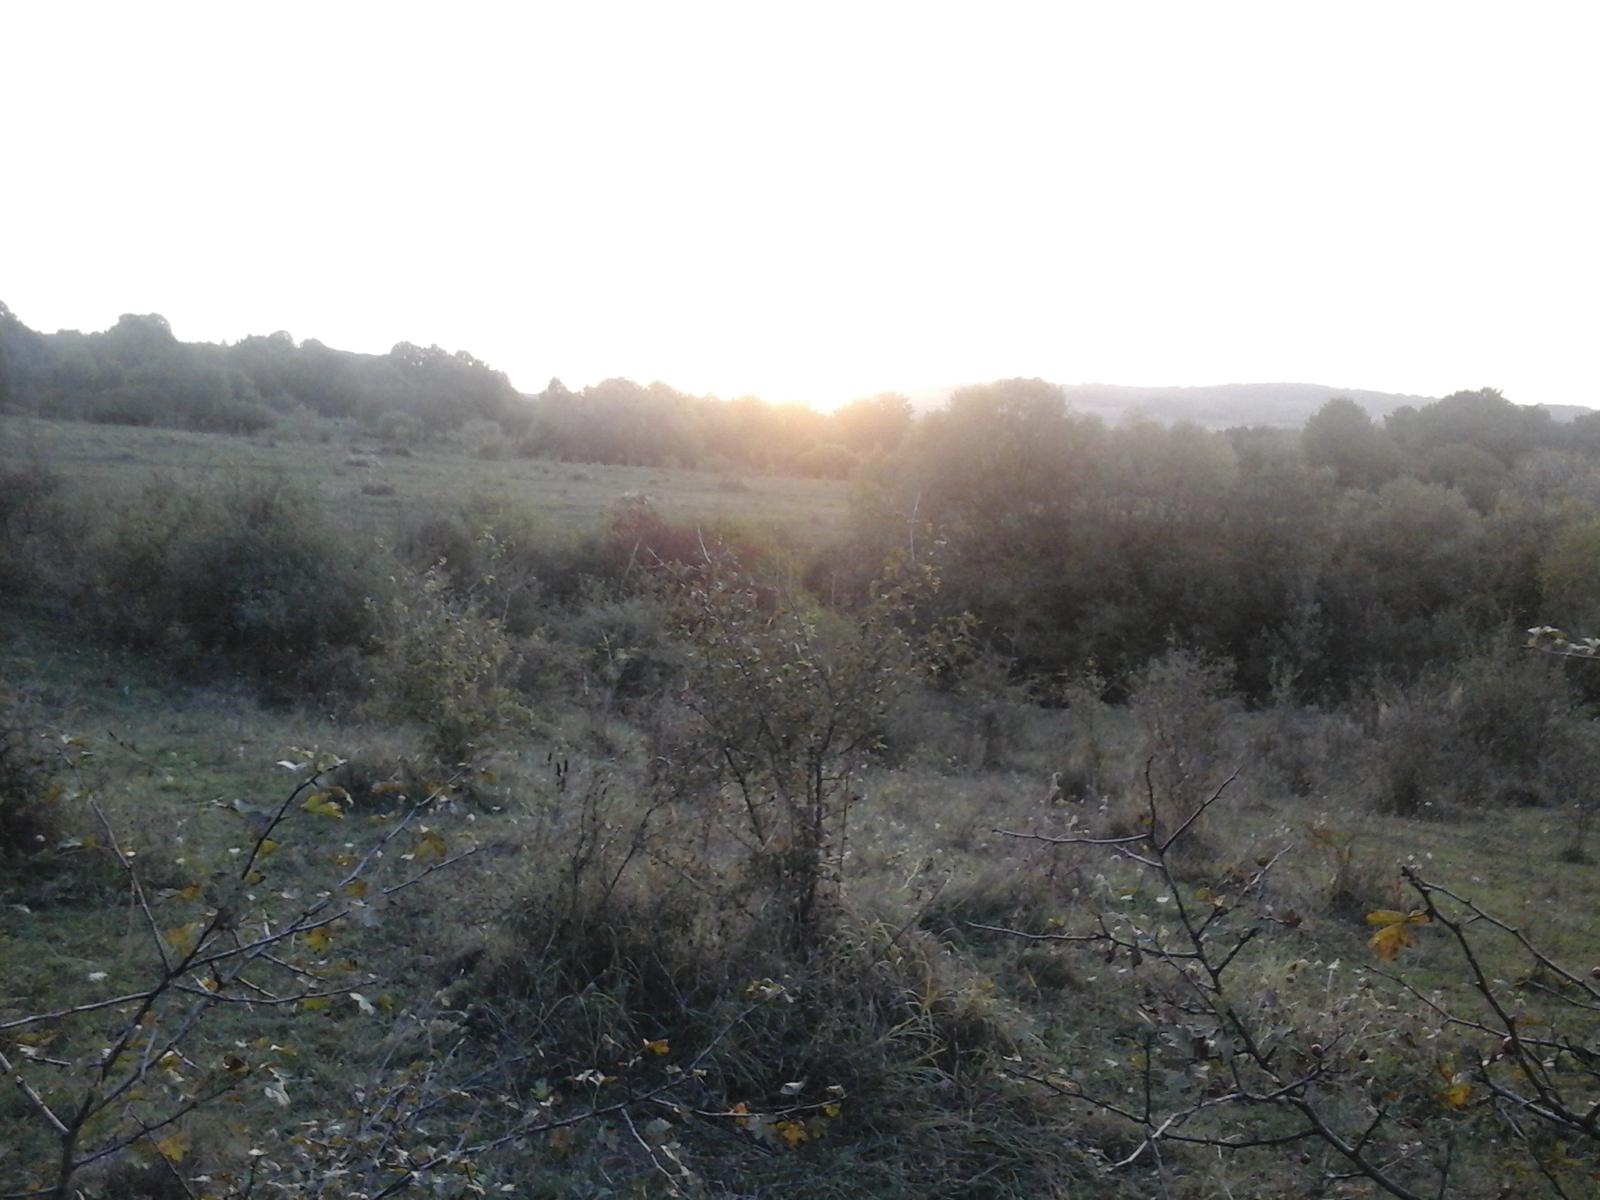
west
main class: Shrubland
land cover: Shrubland without tree cover
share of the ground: > 75 %
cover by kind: shrubs 100 %
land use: Semi-natural and natural areas not in use
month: September
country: RO
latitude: 46.9639
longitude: 24.1048
